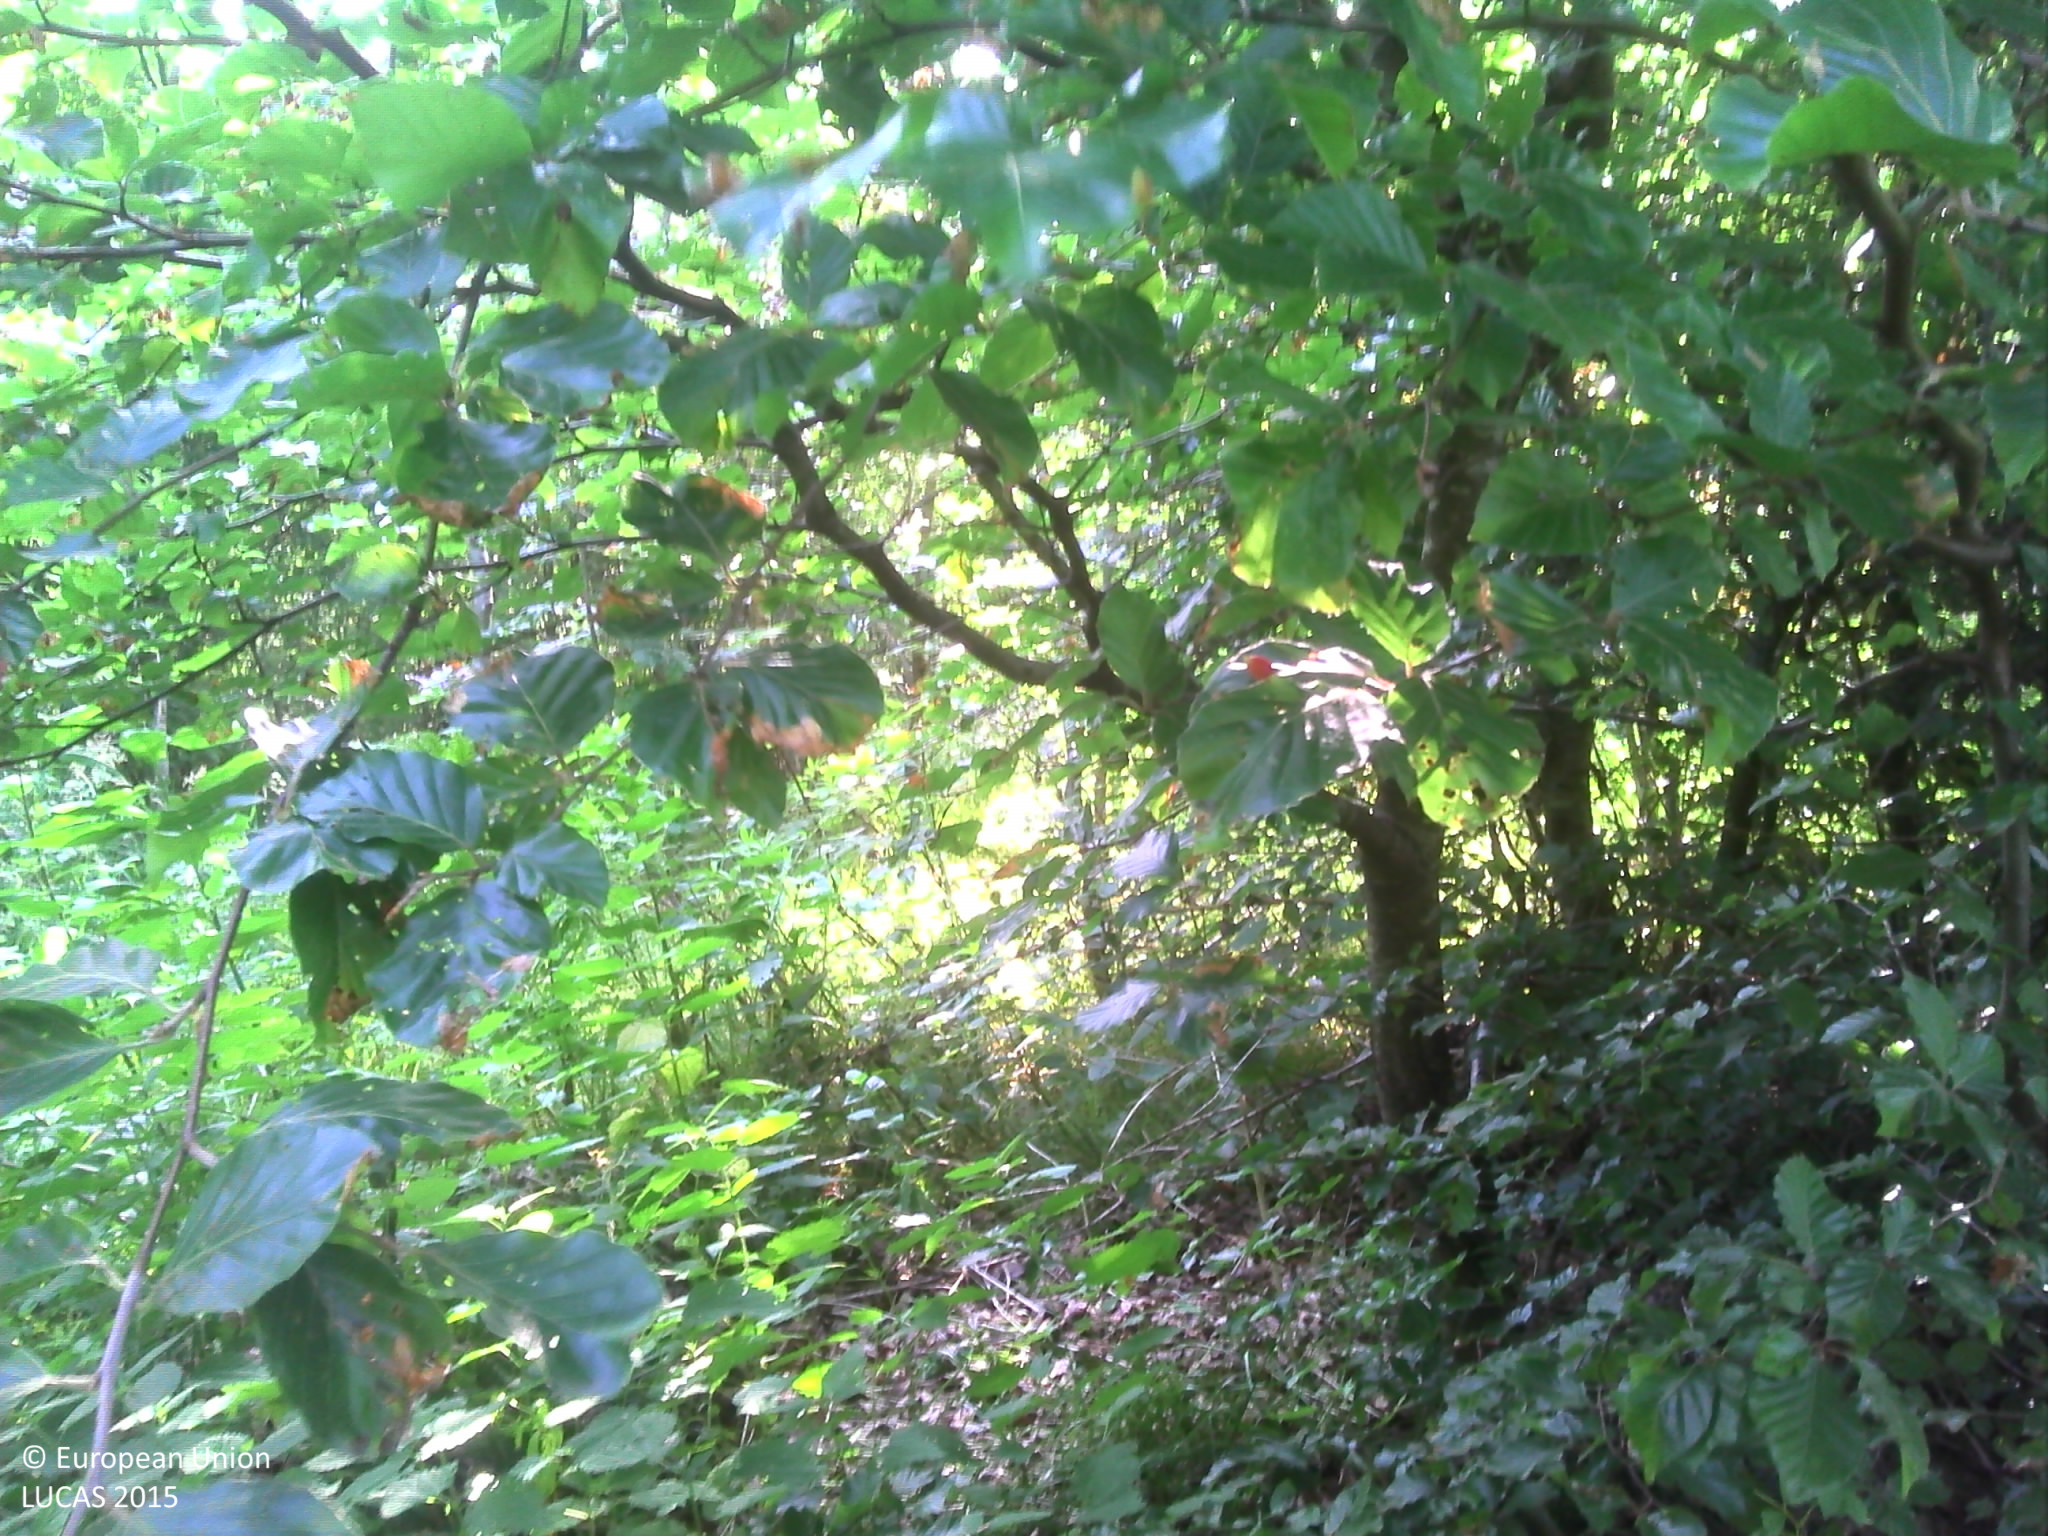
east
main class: Woodland
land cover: Broadleaved woodland
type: acidophilous oak and oak-birch forest
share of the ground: > 75 %
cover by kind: broadleaved forest trees 80 %, herbaceous plants 15 %, shrubs 5 %
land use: Forestry
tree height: > 5 m
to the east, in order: Broadleaved woodland; Tracks; Broadleaved woodland
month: July
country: BE
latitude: 49.9355
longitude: 5.5540
